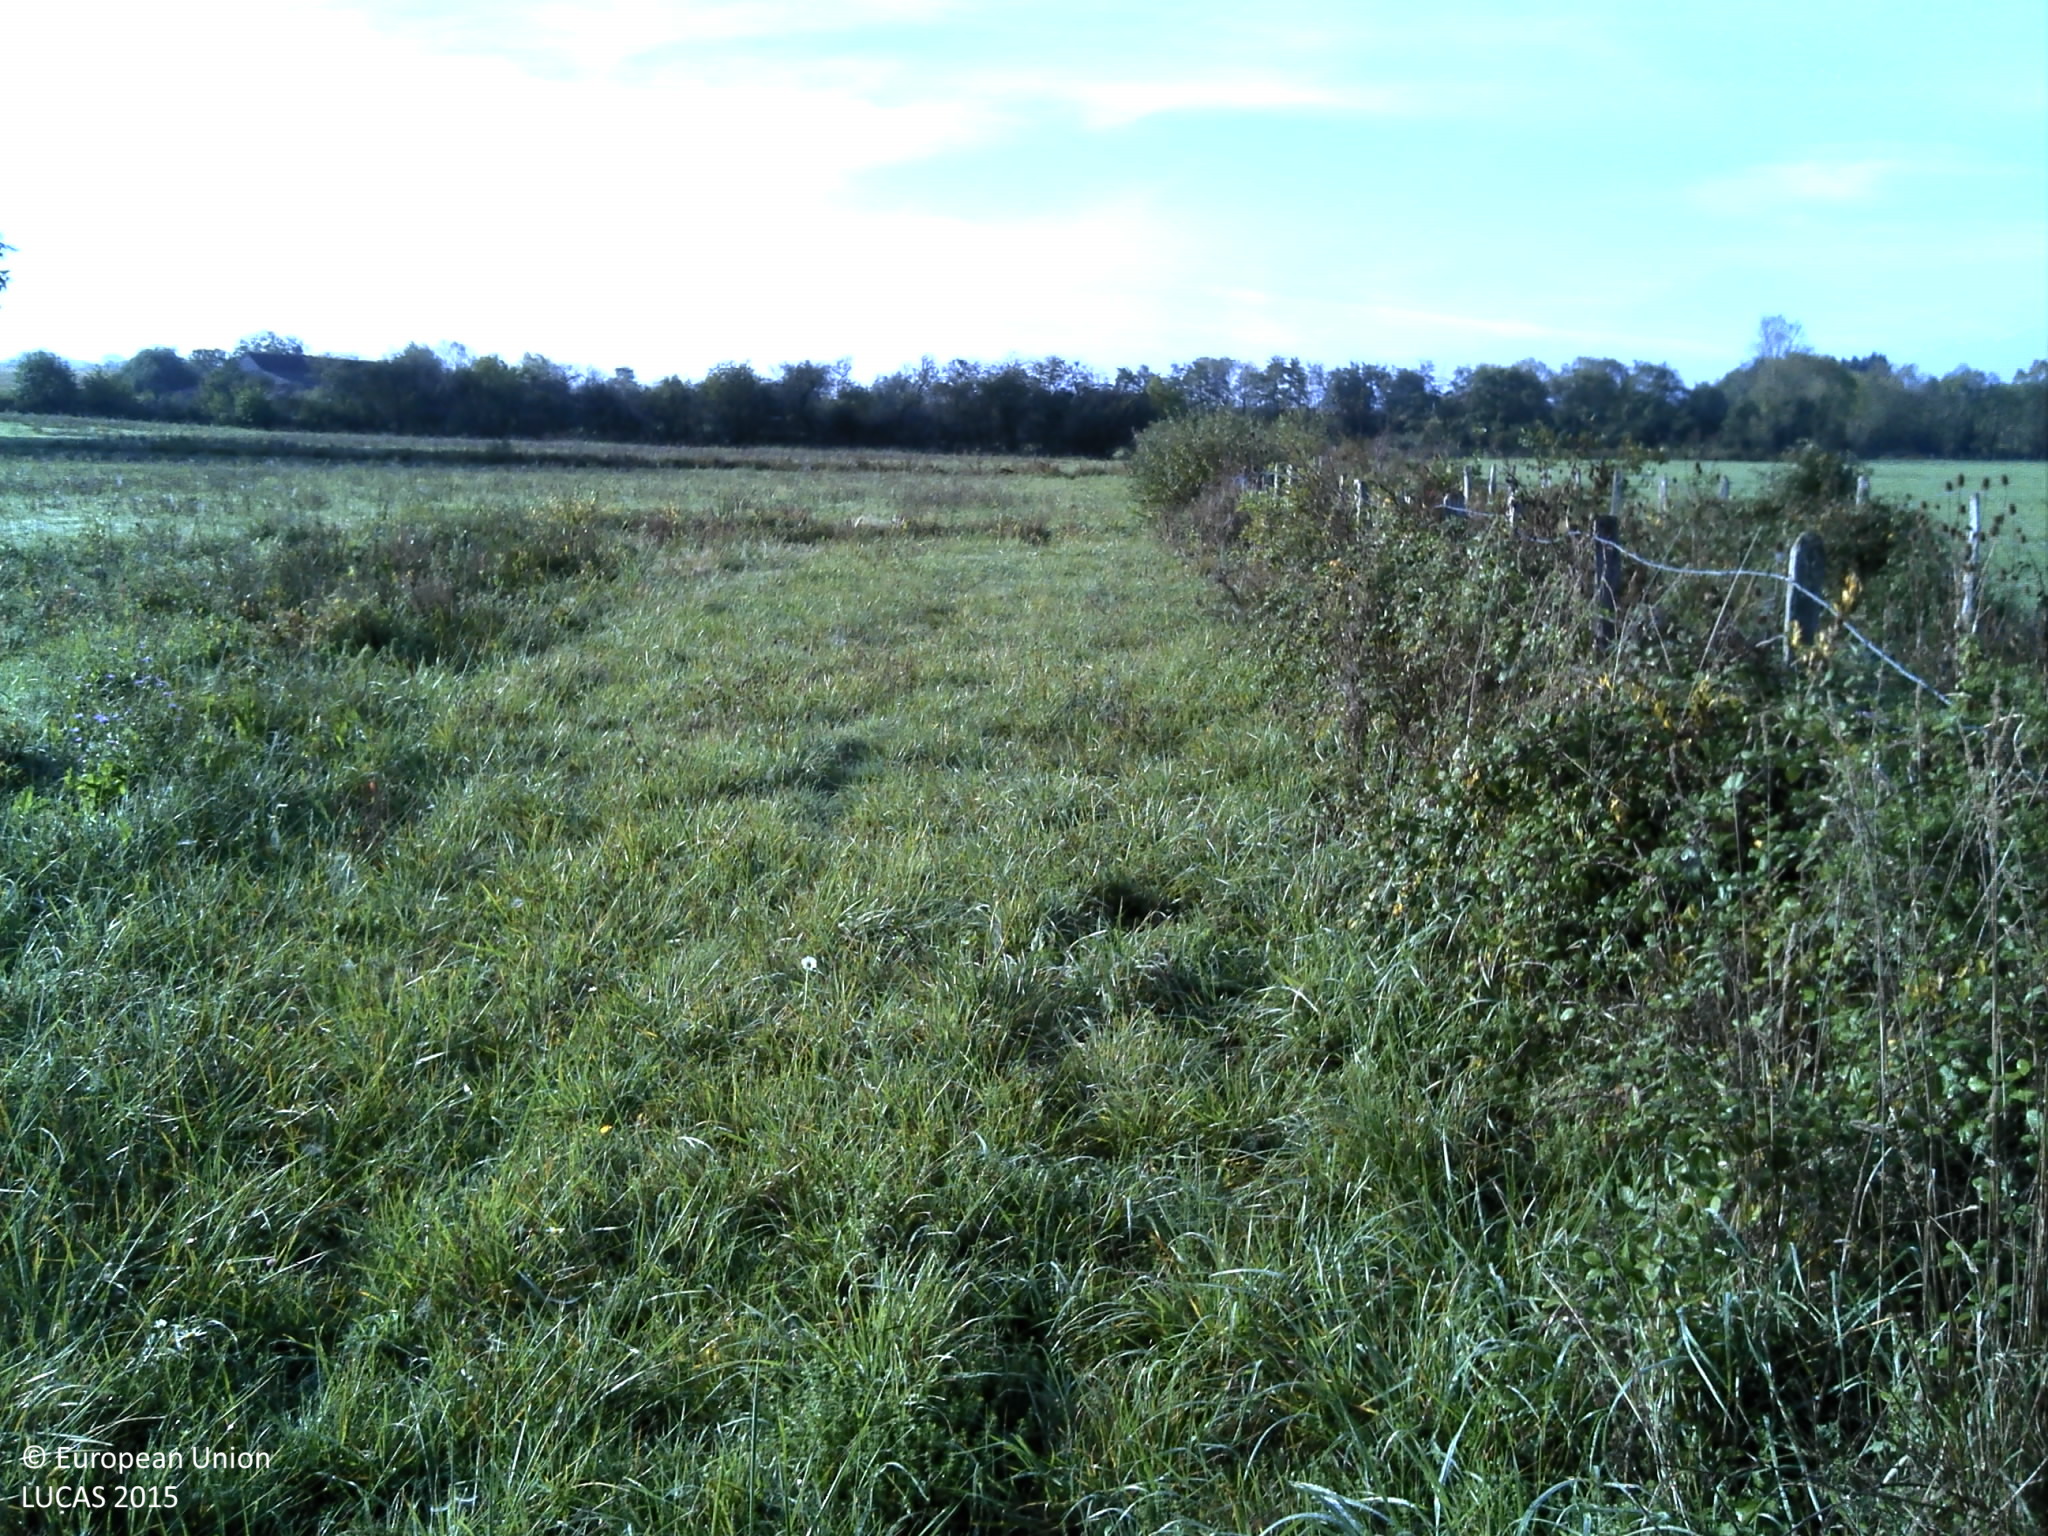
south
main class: Grassland
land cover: Grassland without tree/shrub cover
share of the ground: > 75 %
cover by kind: herbaceous plants 100 %
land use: Agriculture (excluding fallow land and kitchen gardens)
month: October
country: FR
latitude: 46.5926
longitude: 5.3426
